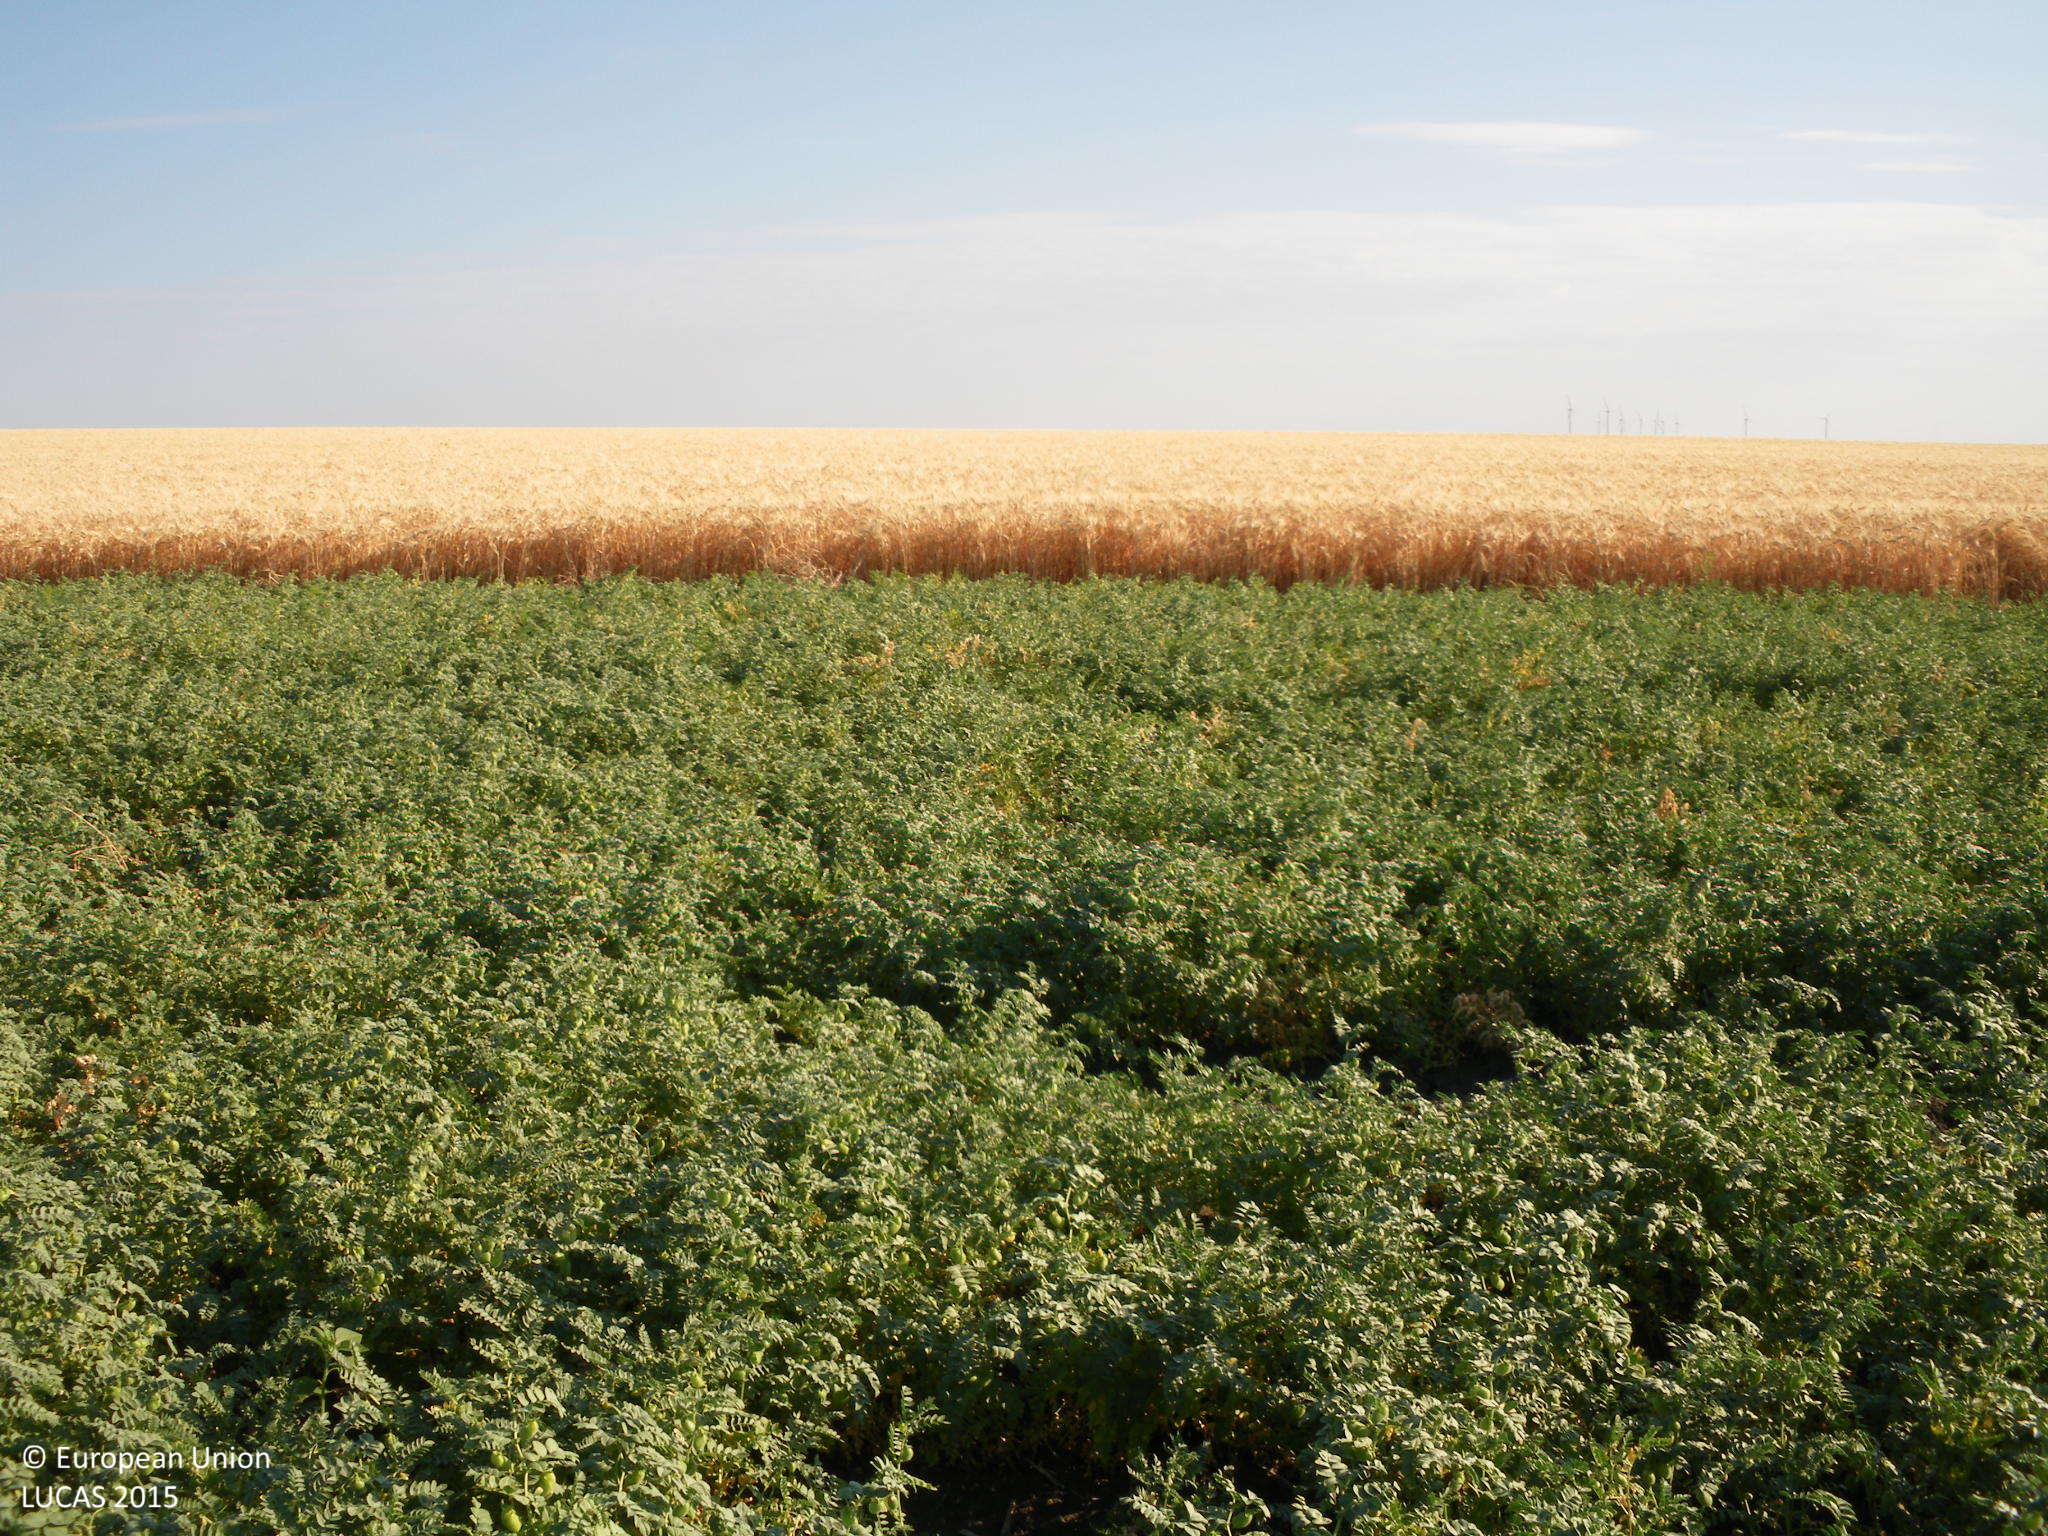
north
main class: Cropland
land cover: Dry pulses
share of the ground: > 75 %
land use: Agriculture (excluding fallow land and kitchen gardens)
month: May
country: ES
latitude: 36.7252
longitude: -6.2617
